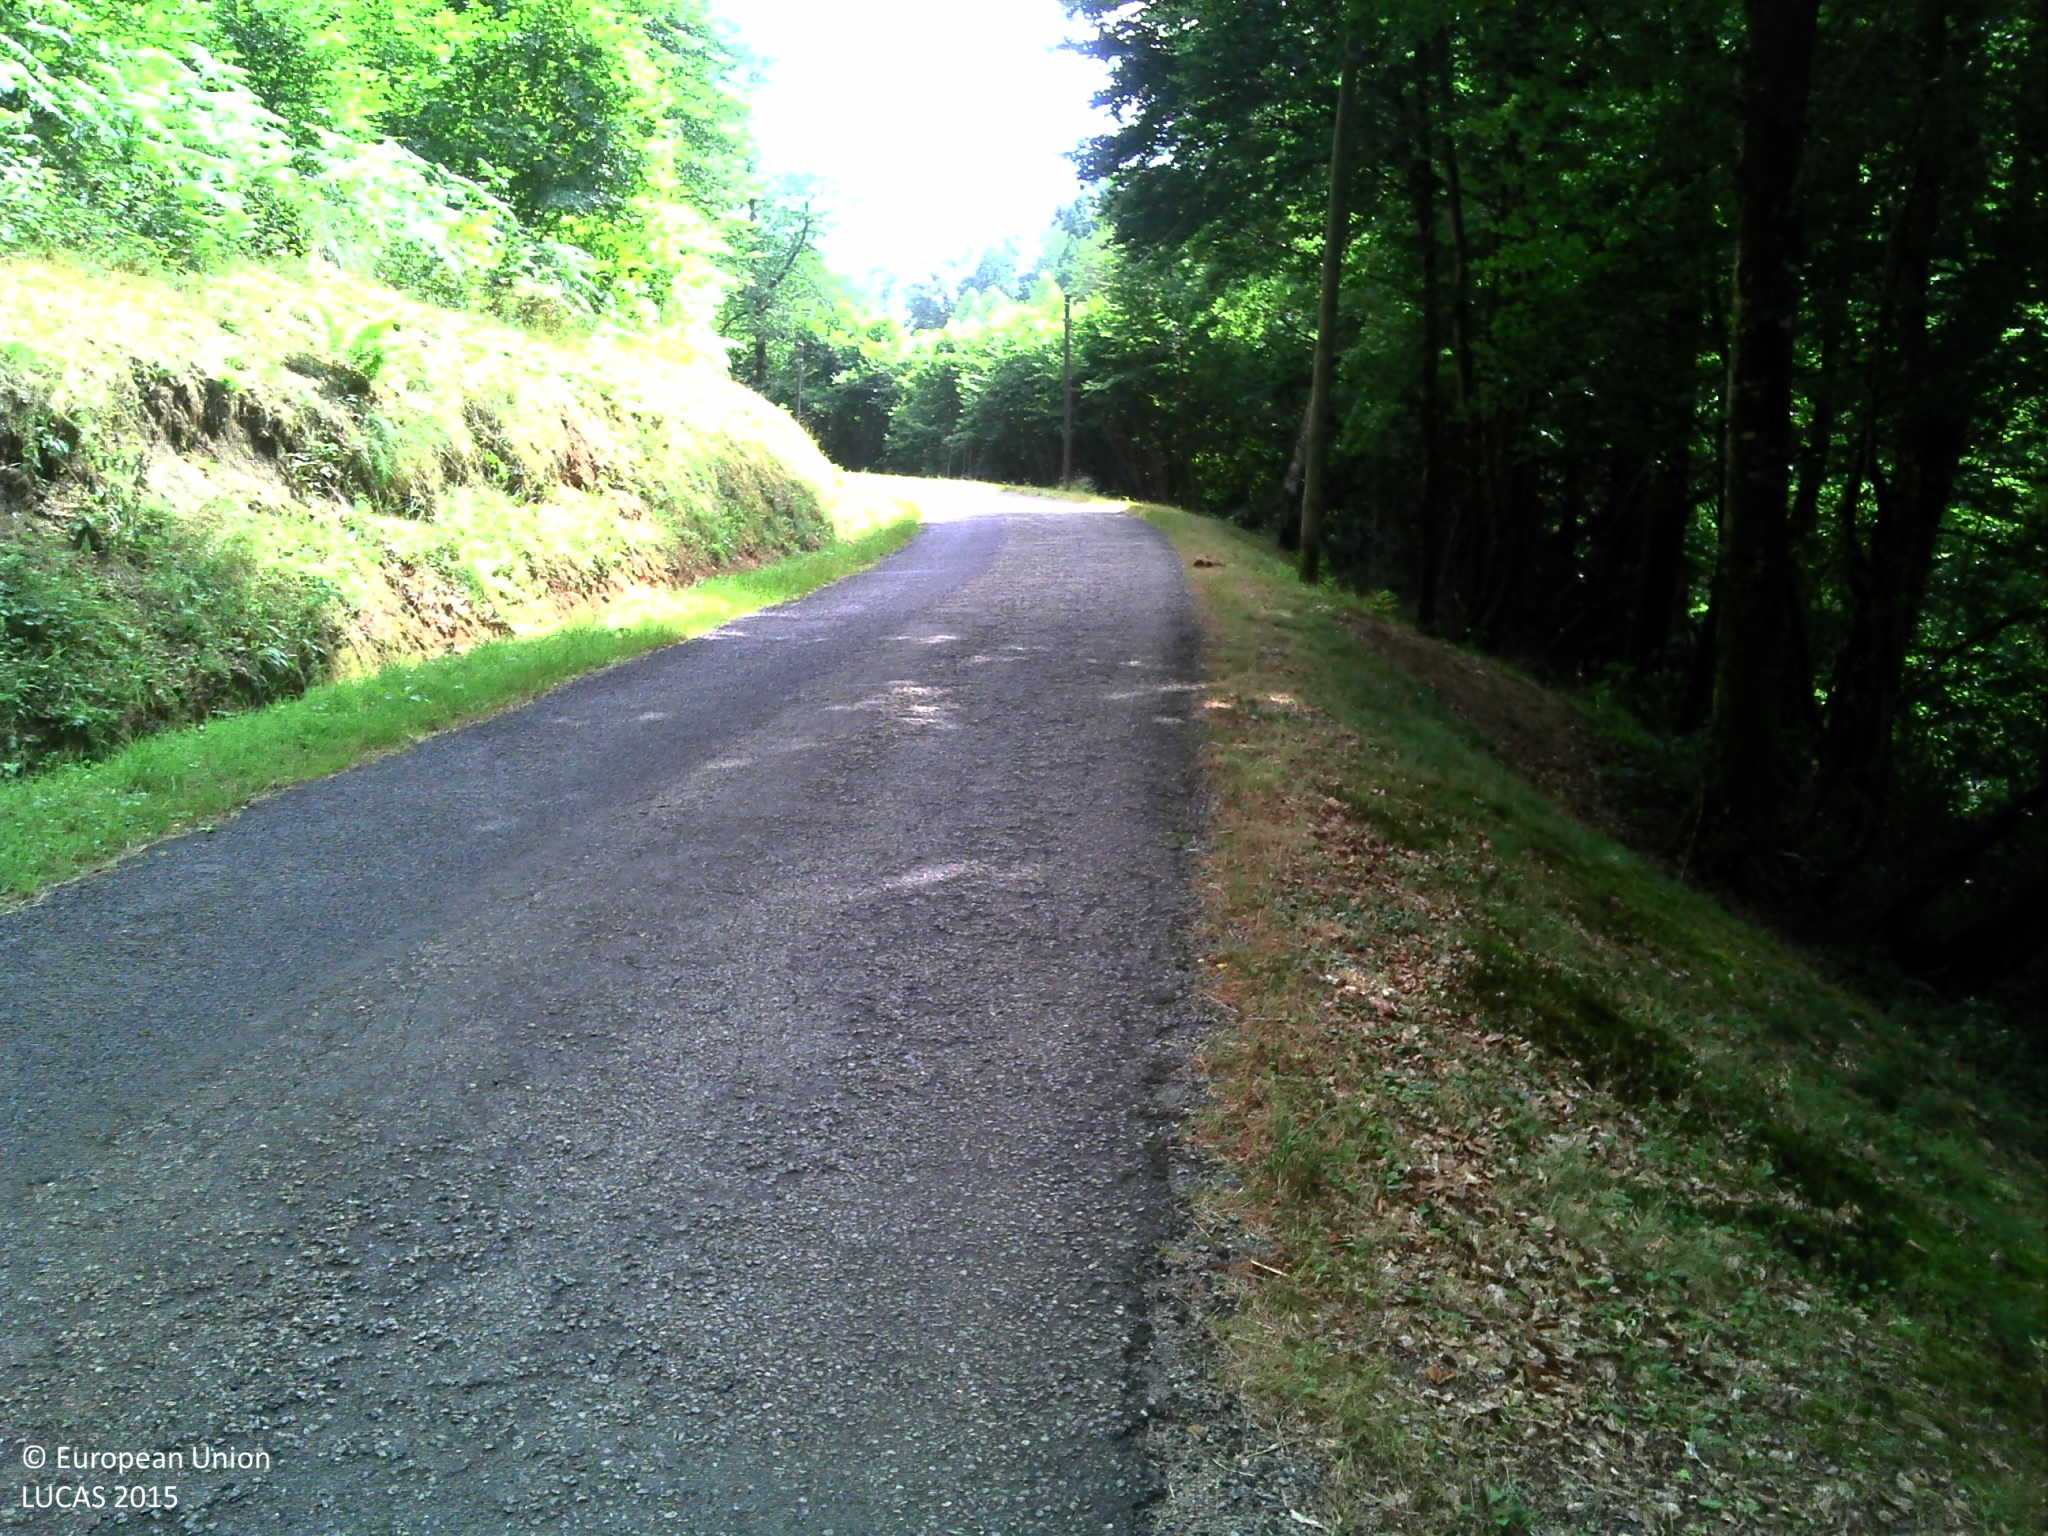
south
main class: Woodland
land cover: Broadleaved woodland
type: beech forest
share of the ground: > 75 %
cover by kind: broadleaved forest trees 70 %, herbaceous plants 25 %, lichens and mosses 5 %
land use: Forestry
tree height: > 5 m
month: July
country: FR
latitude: 45.6593
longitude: 1.8453
